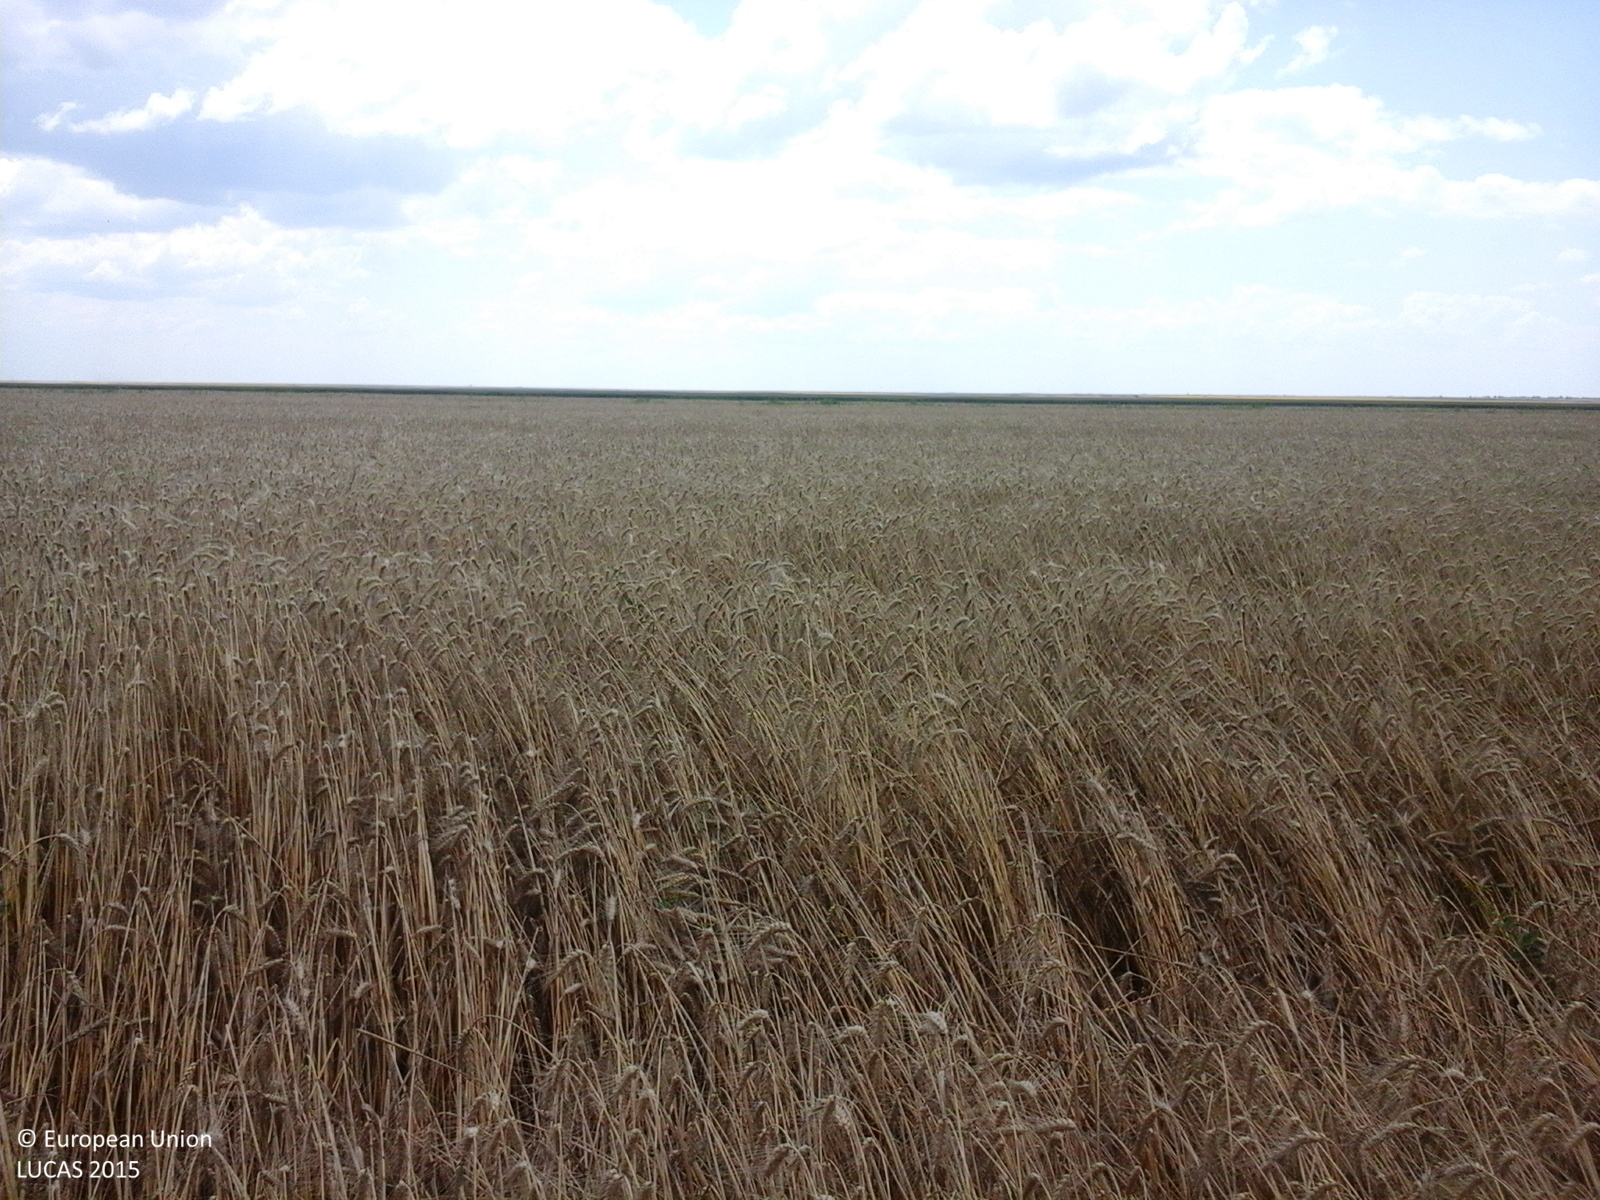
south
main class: Cropland
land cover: Common wheat
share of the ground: > 75 %
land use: Agriculture (excluding fallow land and kitchen gardens)
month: July
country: RO
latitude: 44.0072
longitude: 24.7259
